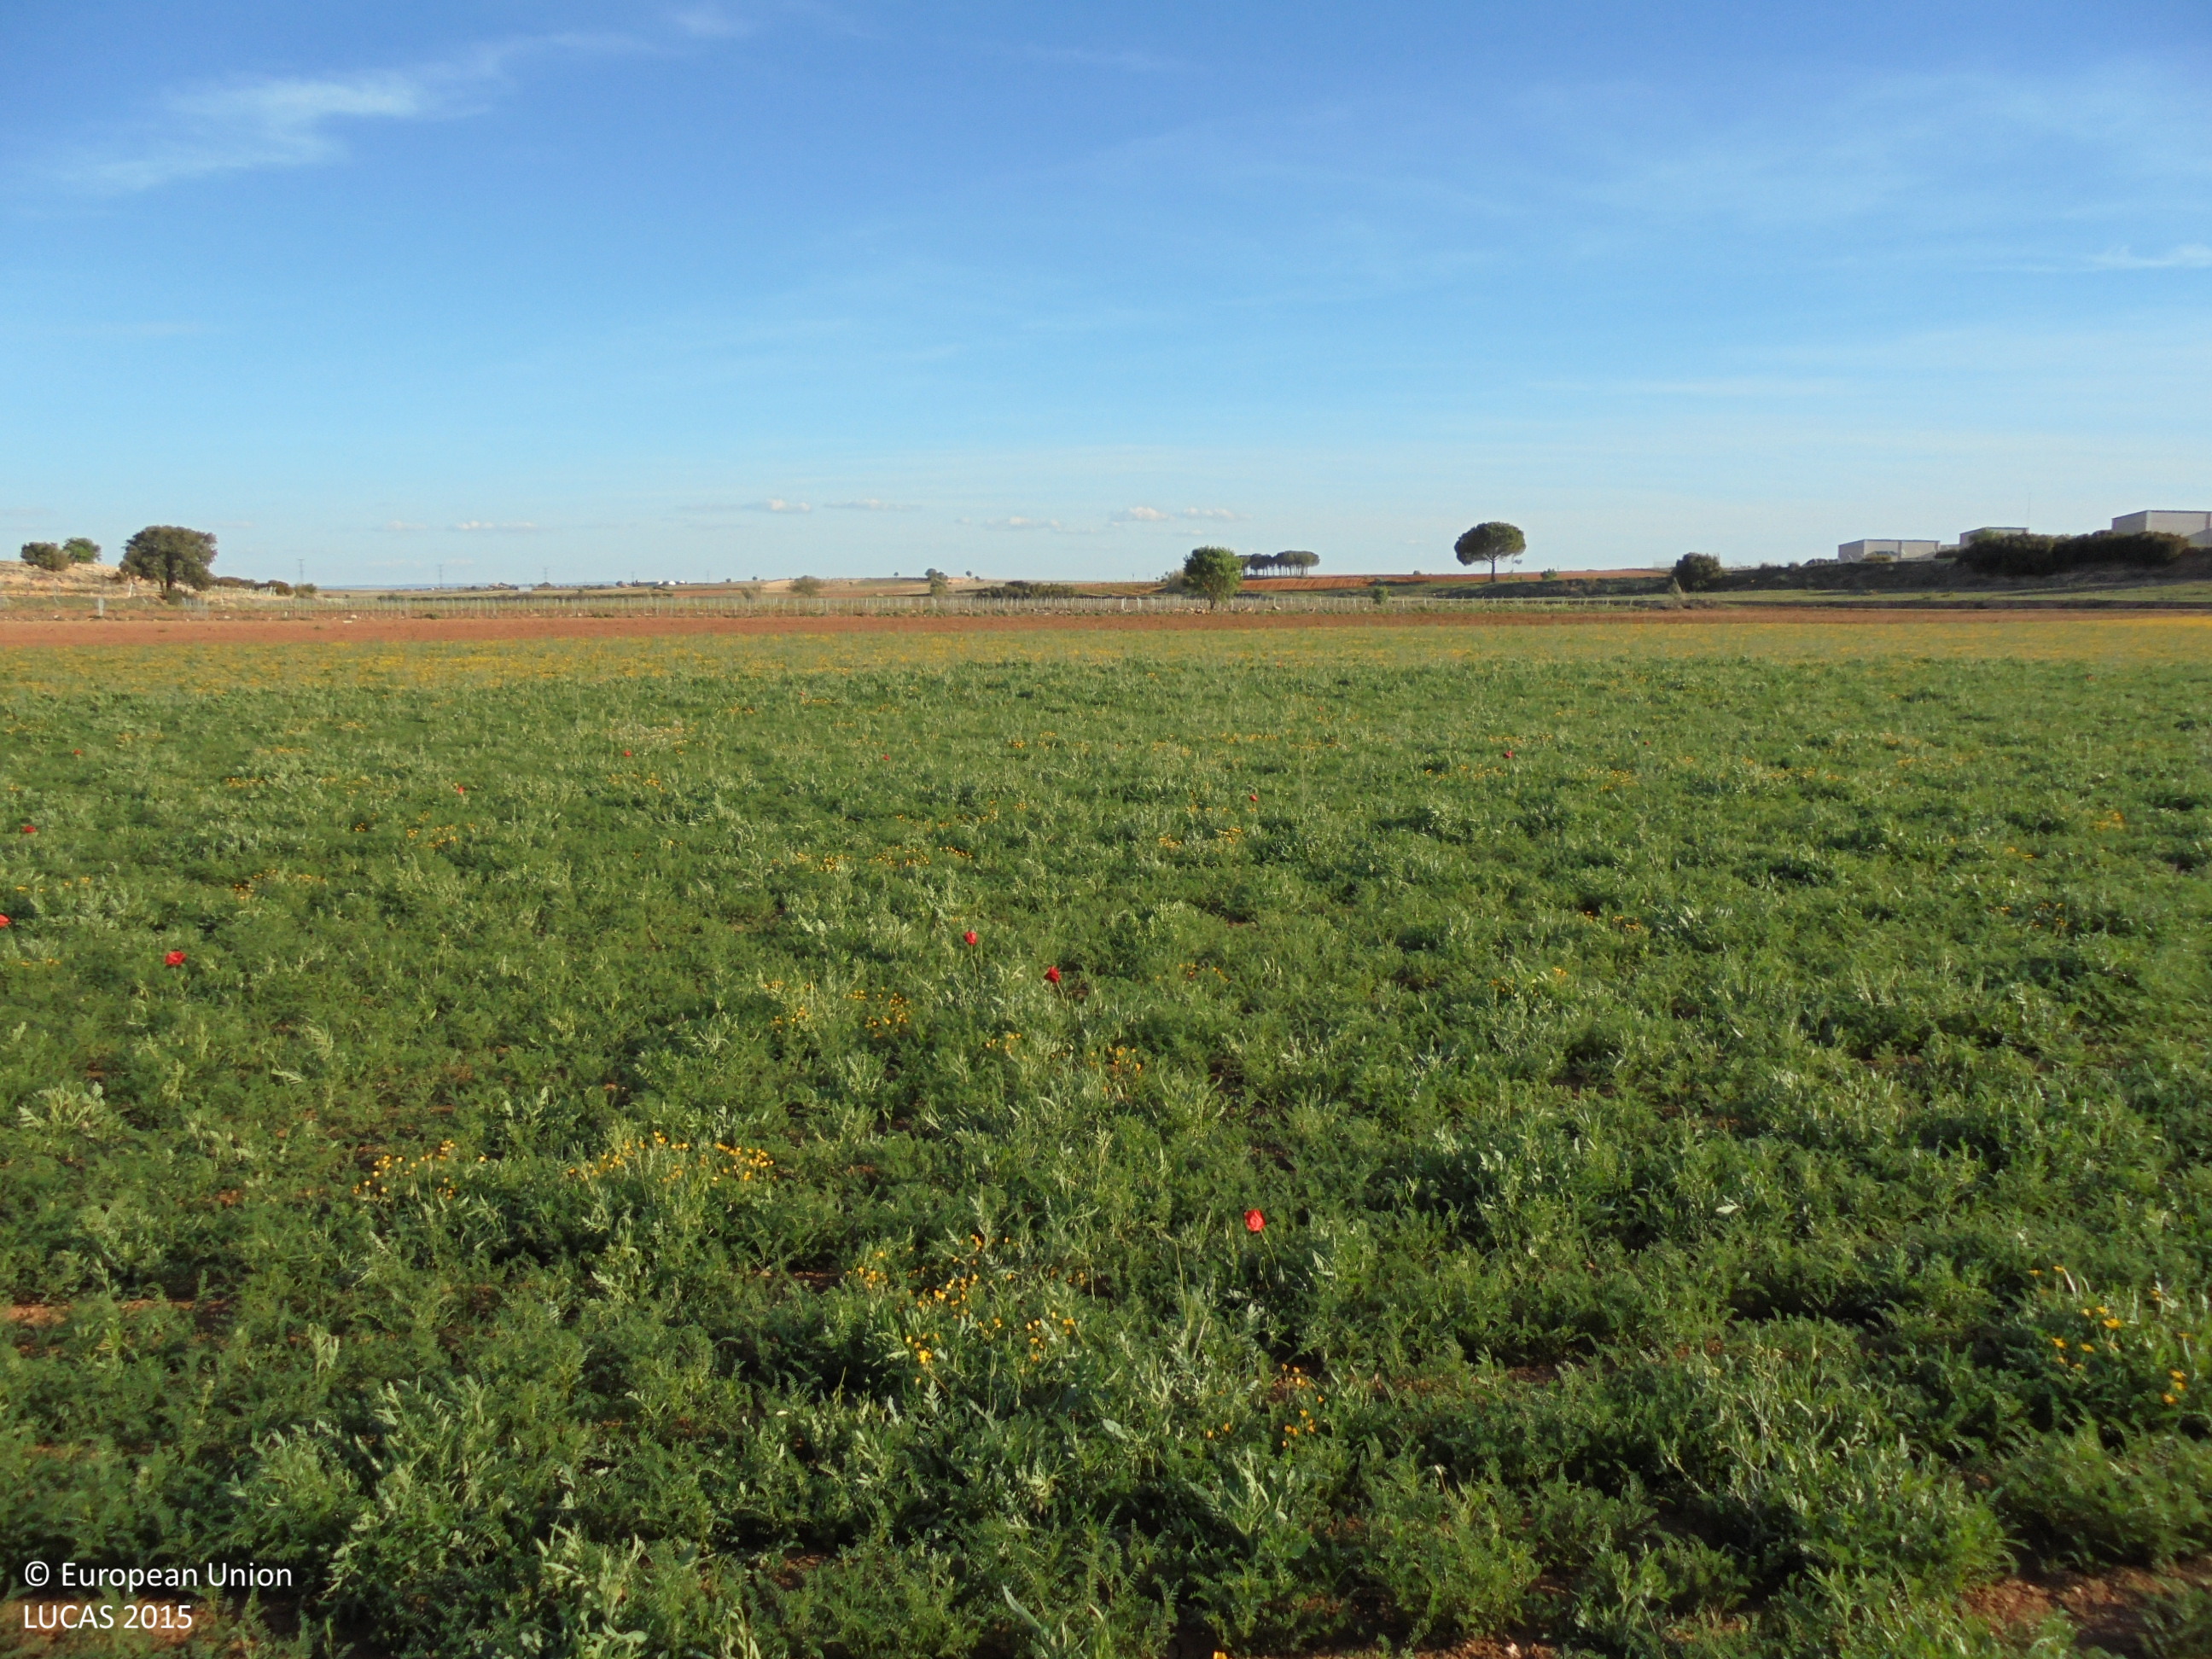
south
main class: Cropland
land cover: Dry pulses
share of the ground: > 75 %
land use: Agriculture (excluding fallow land and kitchen gardens)
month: April
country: ES
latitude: 39.2615
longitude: -1.7897
